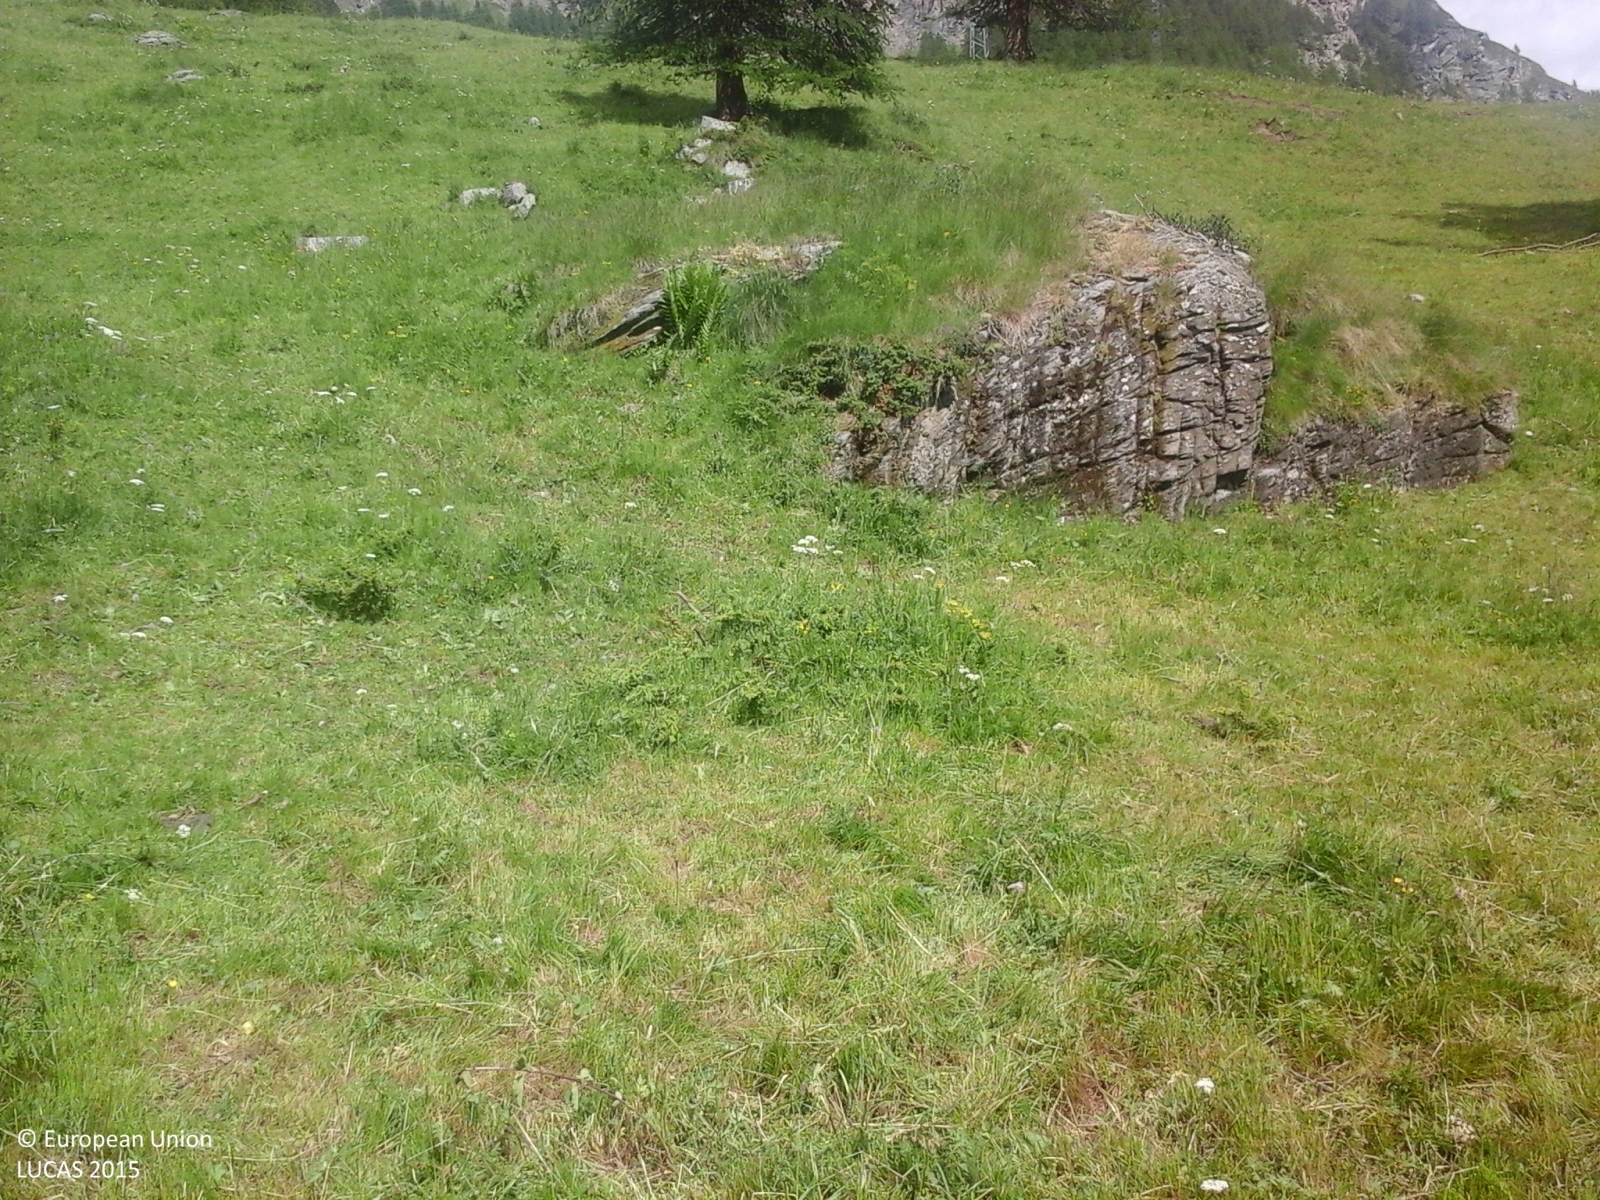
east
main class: Grassland
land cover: Grassland without tree/shrub cover
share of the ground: > 75 %
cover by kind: herbaceous plants 100 %
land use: Agriculture (excluding fallow land and kitchen gardens)
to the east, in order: Grassland without tree/shrub cover; Rock outcrops; Grassland without tree/shrub cover; Single bushes/trees; Grassland without tree/shrub cover; Tracks; Grassland without tree/shrub cover; Electric lines; Grassland without tree/shrub cover; Ditches and canals; Grassland without tree/shrub cover; Ditches and canals; Grassland without tree/shrub cover; Electric lines; Grassland without tree/shrub cover; Railways; Lines of trees
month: June
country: IT
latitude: 45.9102
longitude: 7.6183
